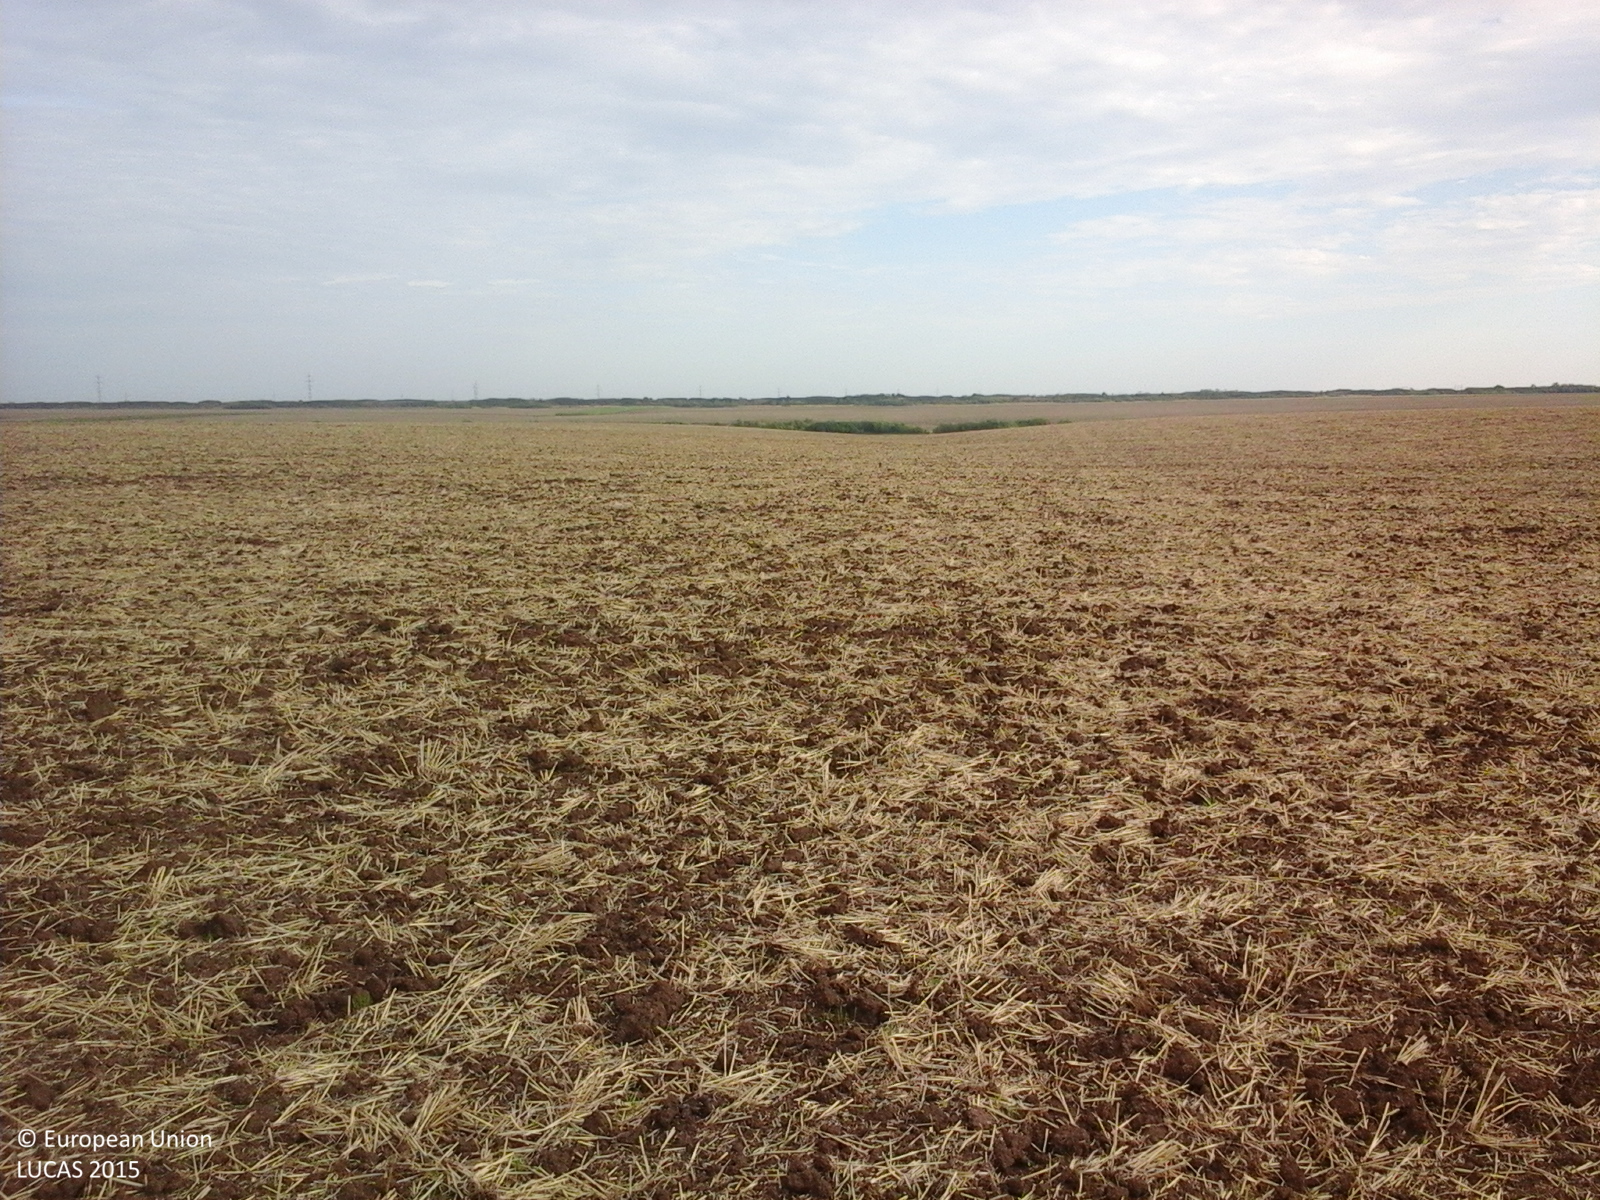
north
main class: Cropland
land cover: Common wheat
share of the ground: 25 - 50 %
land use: Agriculture (excluding fallow land and kitchen gardens)
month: August
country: RO
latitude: 46.0904
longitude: 21.3506
